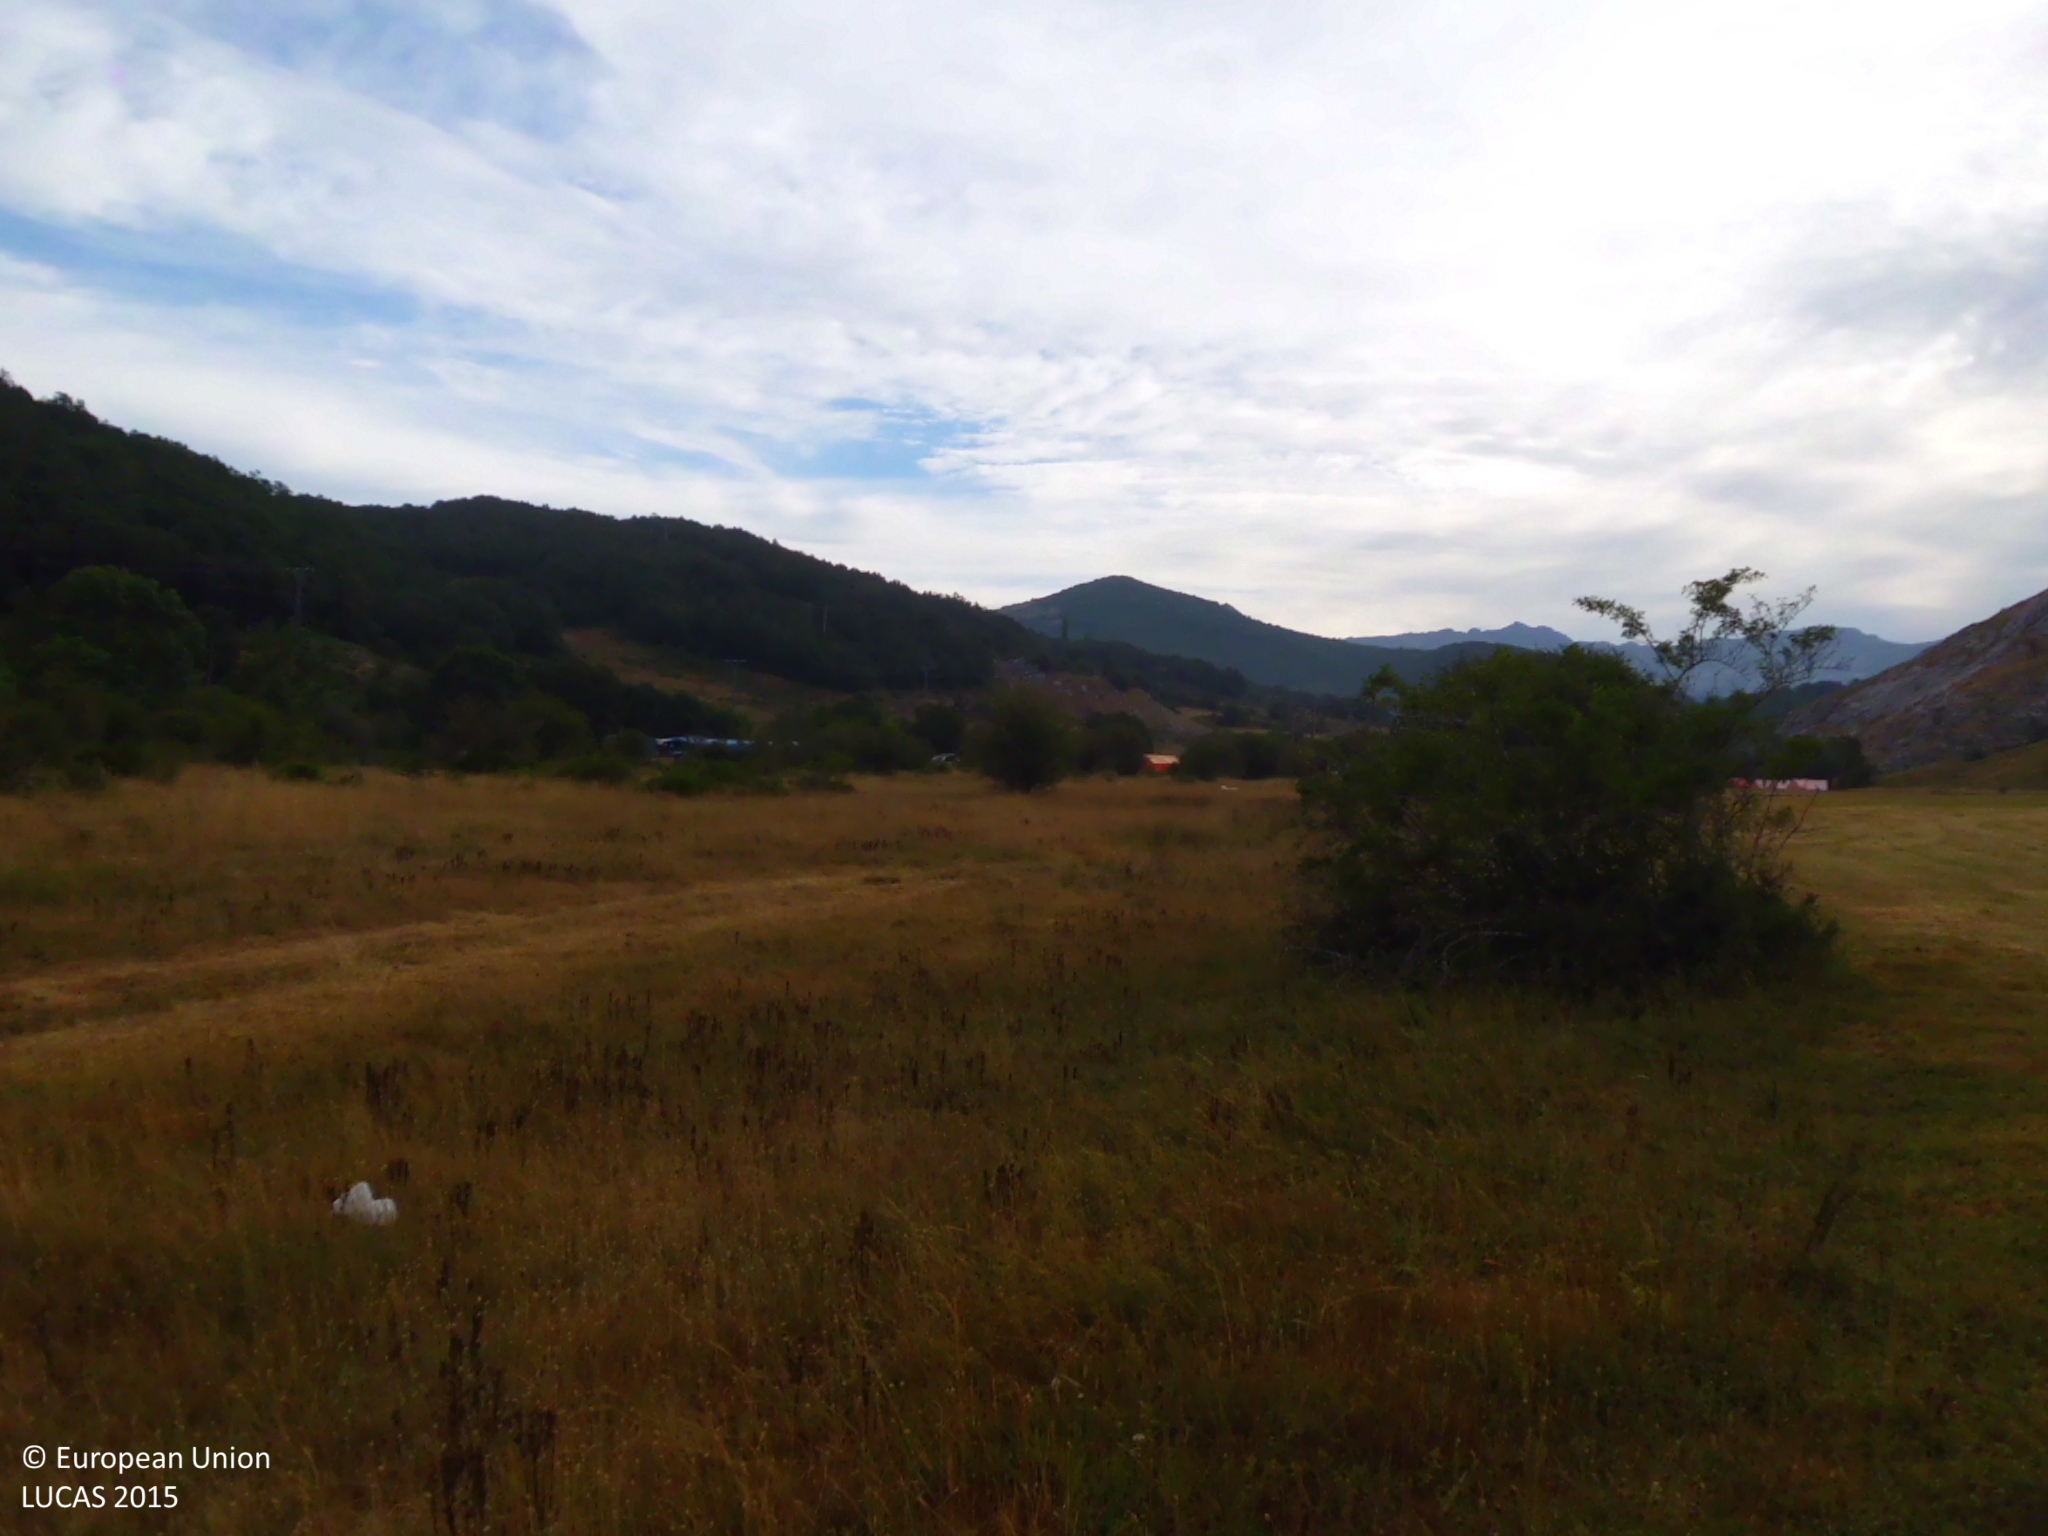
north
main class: Grassland
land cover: Grassland without tree/shrub cover
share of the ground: > 75 %
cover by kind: herbaceous plants 100 %
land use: Agriculture (excluding fallow land and kitchen gardens)
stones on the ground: 25 - 50 %
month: July
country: ES
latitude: 42.9795
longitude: -4.4892
